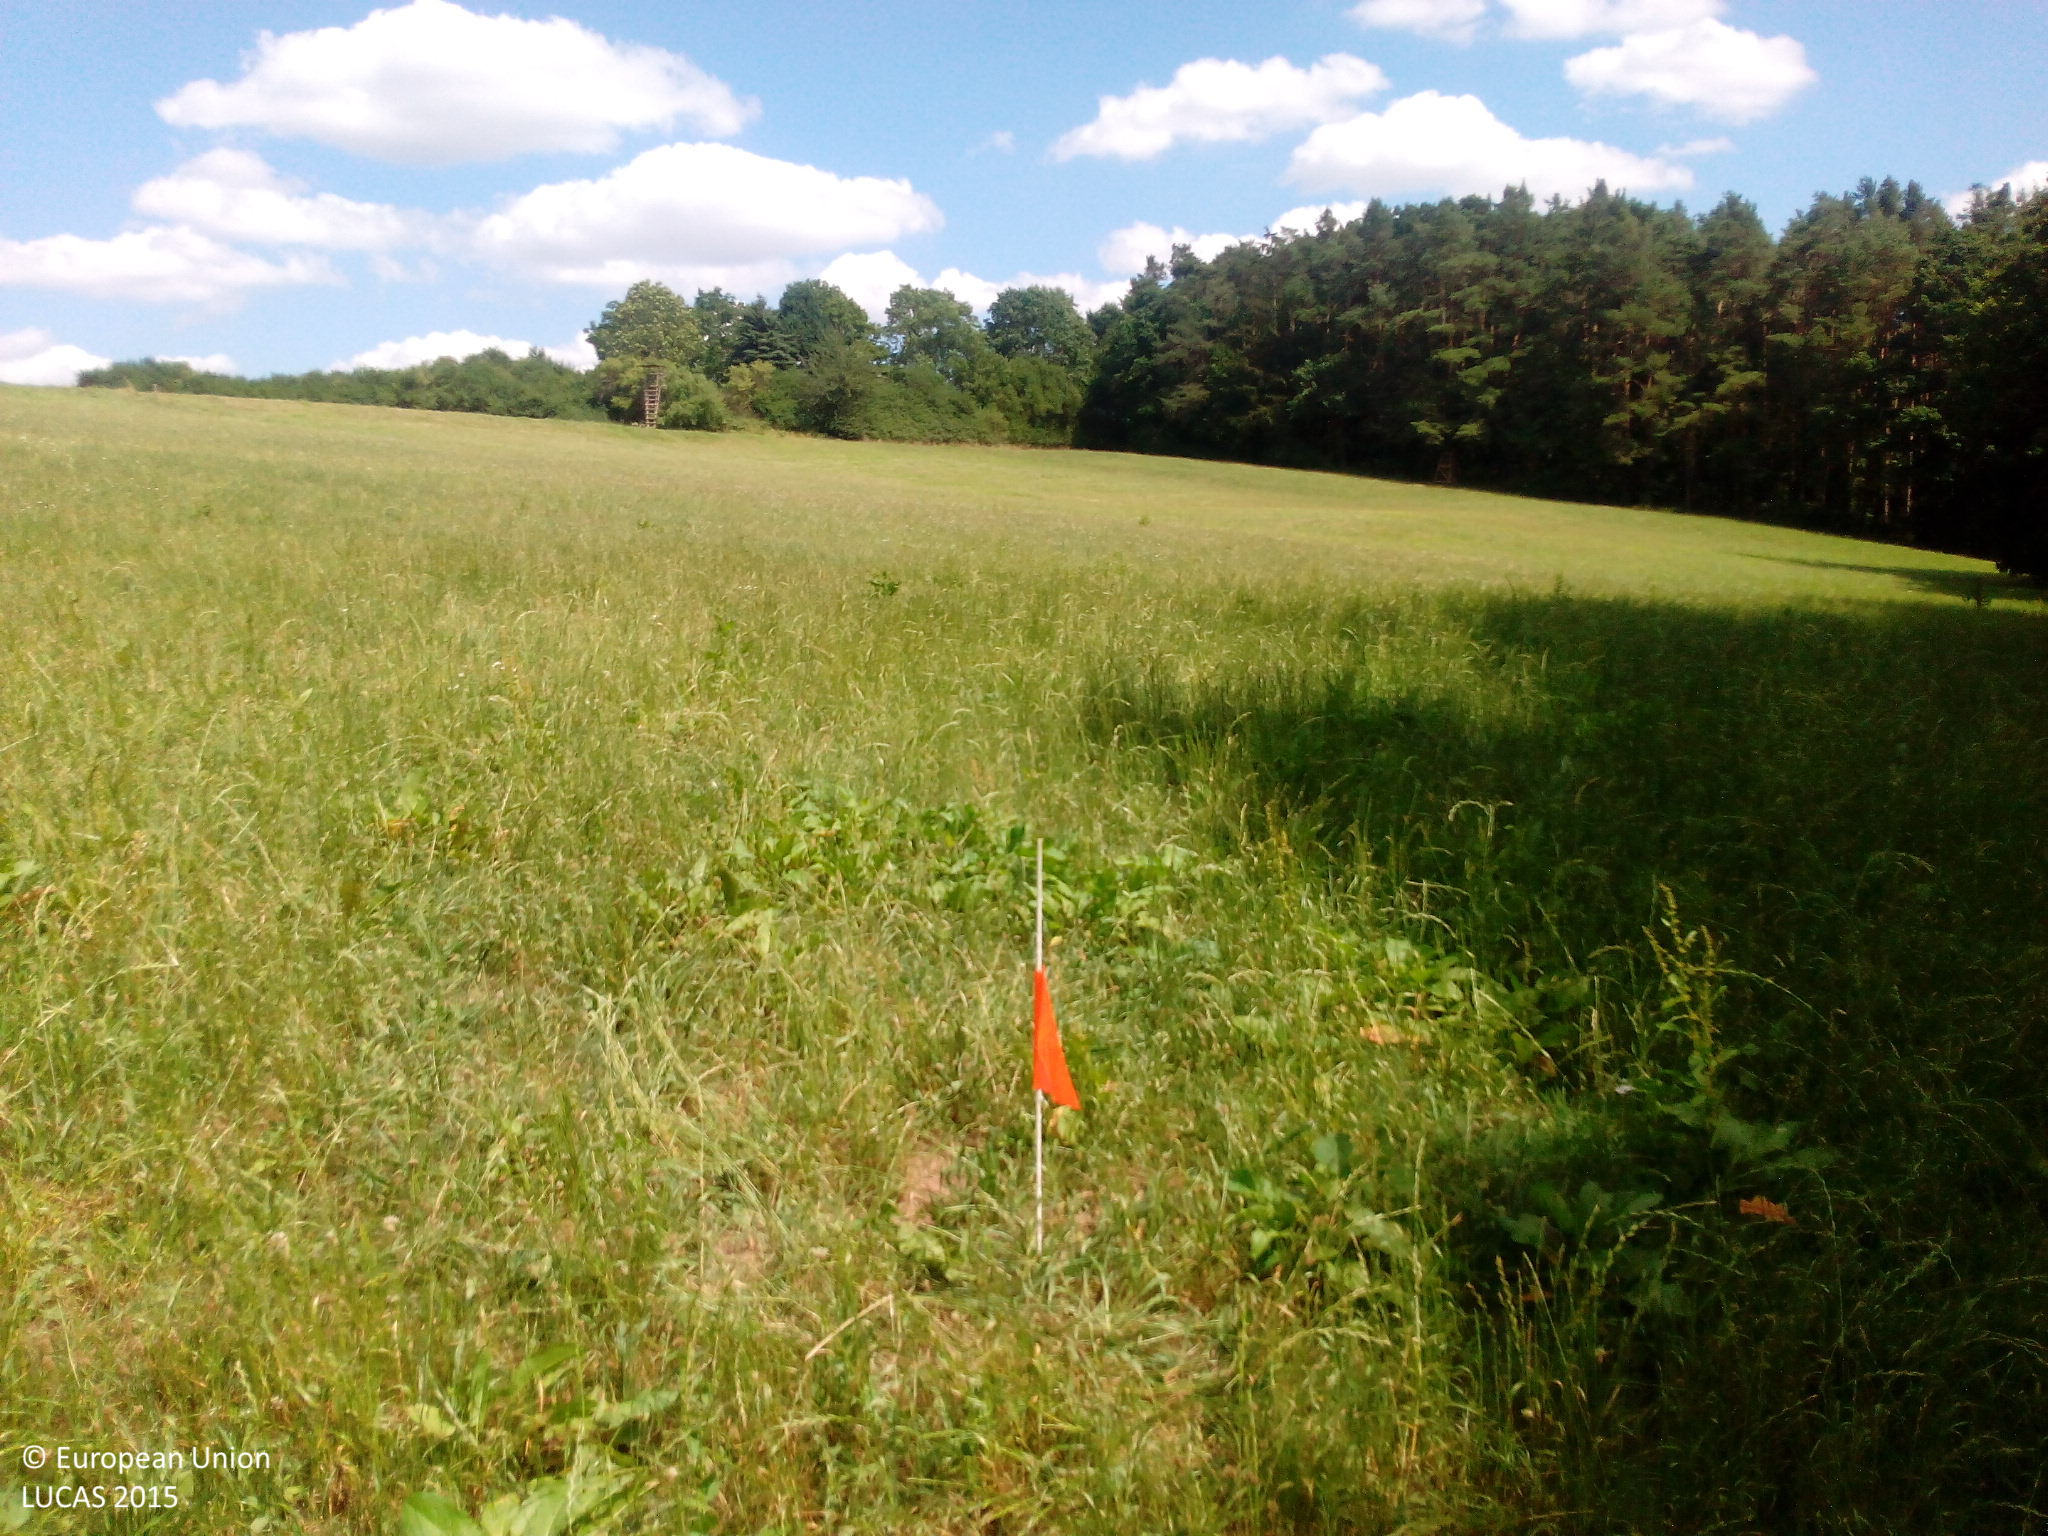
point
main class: Grassland
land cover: Grassland without tree/shrub cover
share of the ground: > 75 %
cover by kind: herbaceous plants 100 %
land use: Agriculture (excluding fallow land and kitchen gardens)
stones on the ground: < 10 %
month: July
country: DE
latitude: 49.4433
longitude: 10.8962
